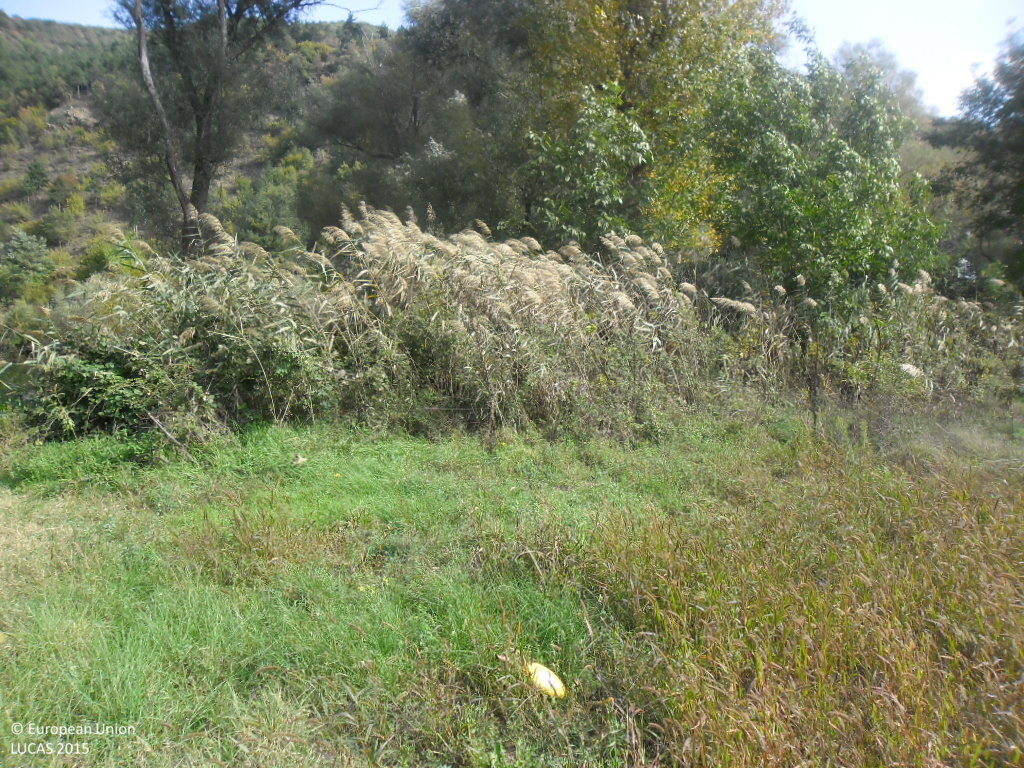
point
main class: Grassland
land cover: Spontaneously vegetated surfaces
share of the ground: > 75 %
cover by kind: herbaceous plants 100 %
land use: Agriculture (excluding fallow land and kitchen gardens)
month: October
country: BG
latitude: 41.9261
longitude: 23.1073
